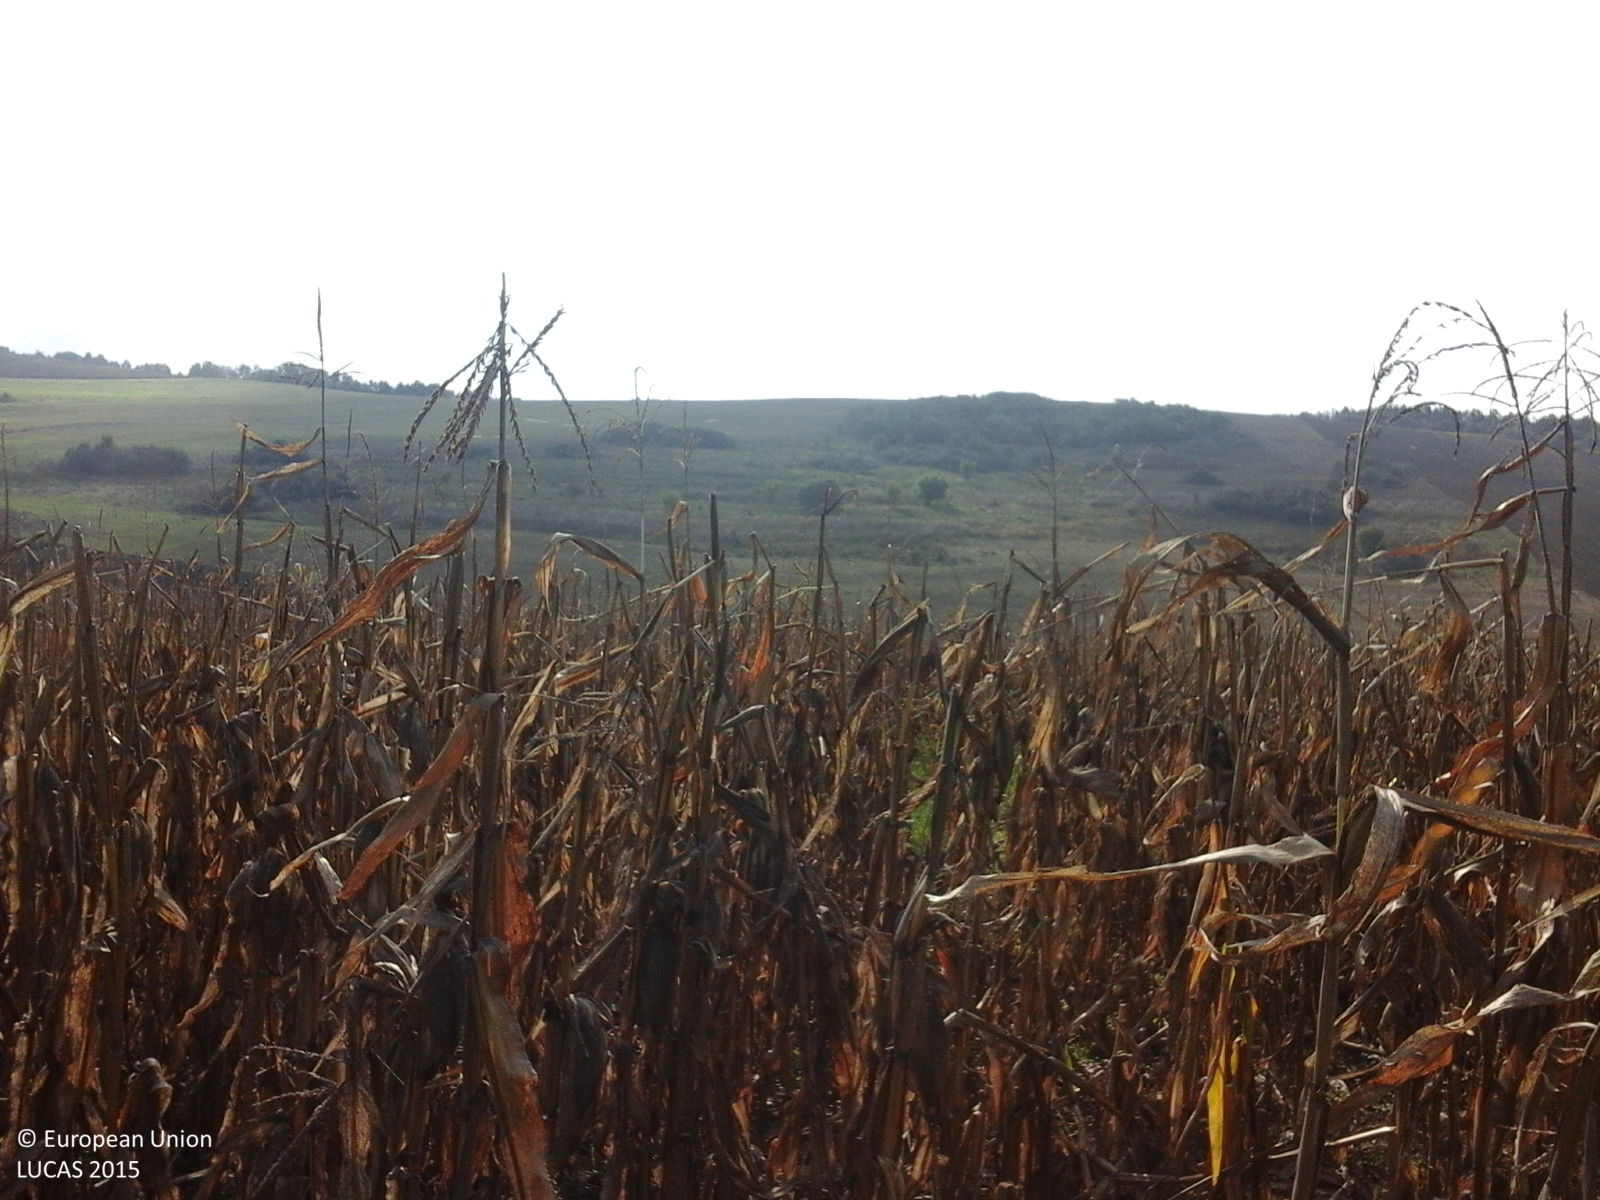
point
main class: Cropland
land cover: Maize
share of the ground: > 75 %
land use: Agriculture (excluding fallow land and kitchen gardens)
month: October
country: RO
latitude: 46.4045
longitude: 24.3258
